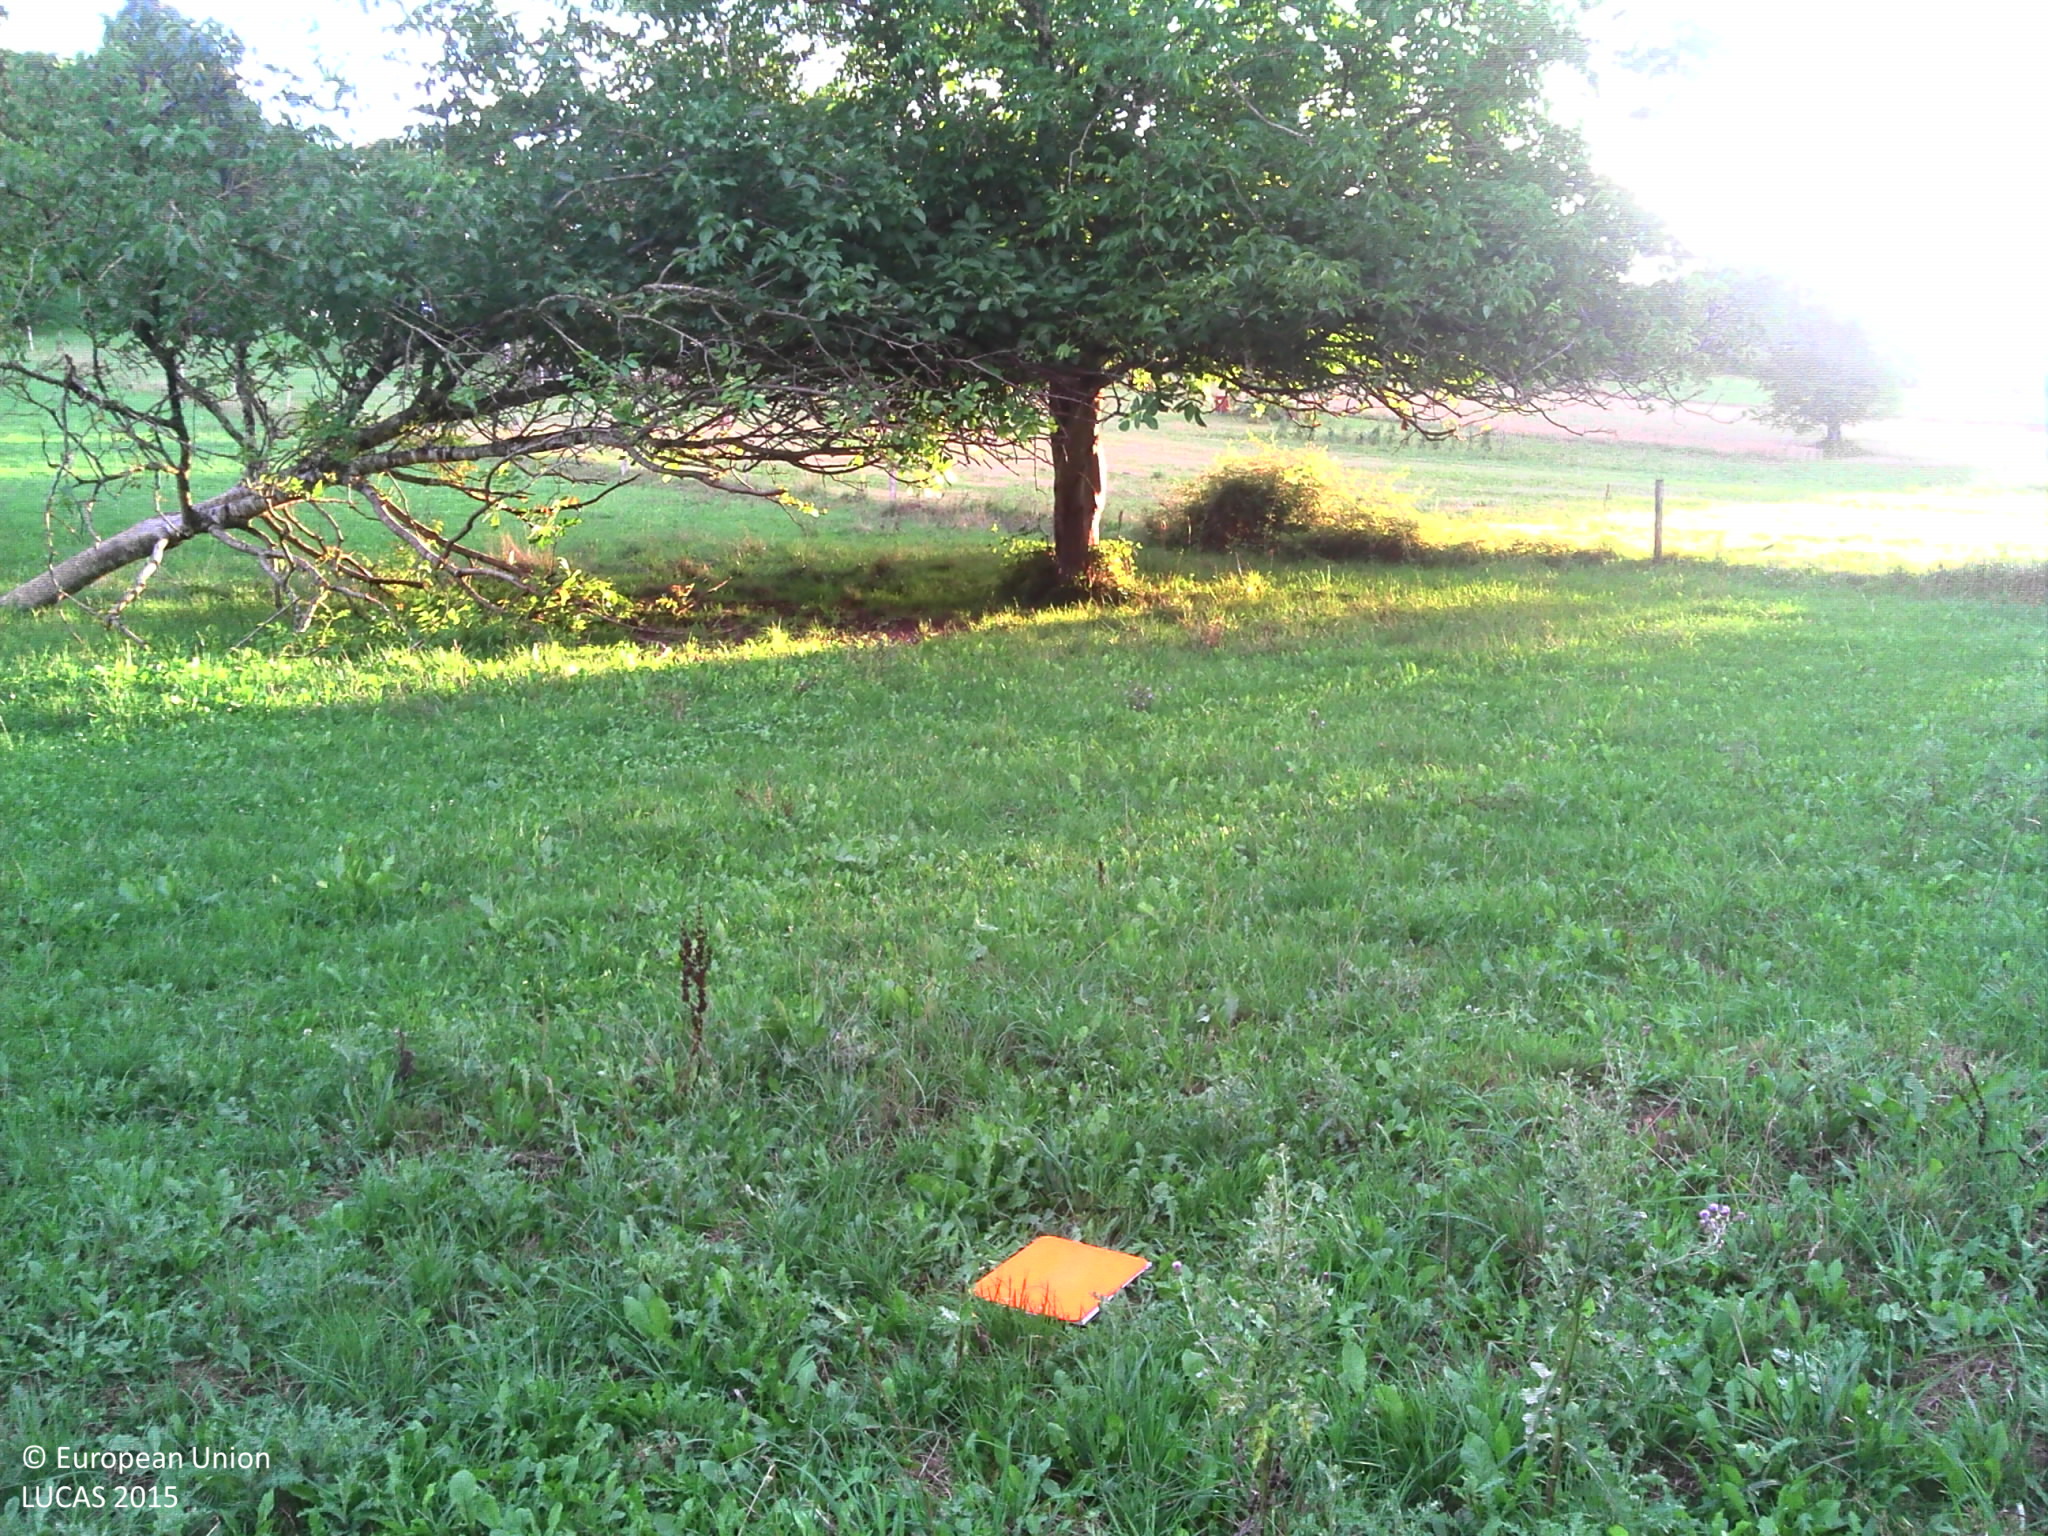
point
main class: Grassland
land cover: Grassland with sparse tree/shrub cover
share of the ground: > 75 %
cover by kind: herbaceous plants 95 %, broadleaved forest trees 5 %
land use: Agriculture (excluding fallow land and kitchen gardens)
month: August
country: FR
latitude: 45.4350
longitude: 0.6698
